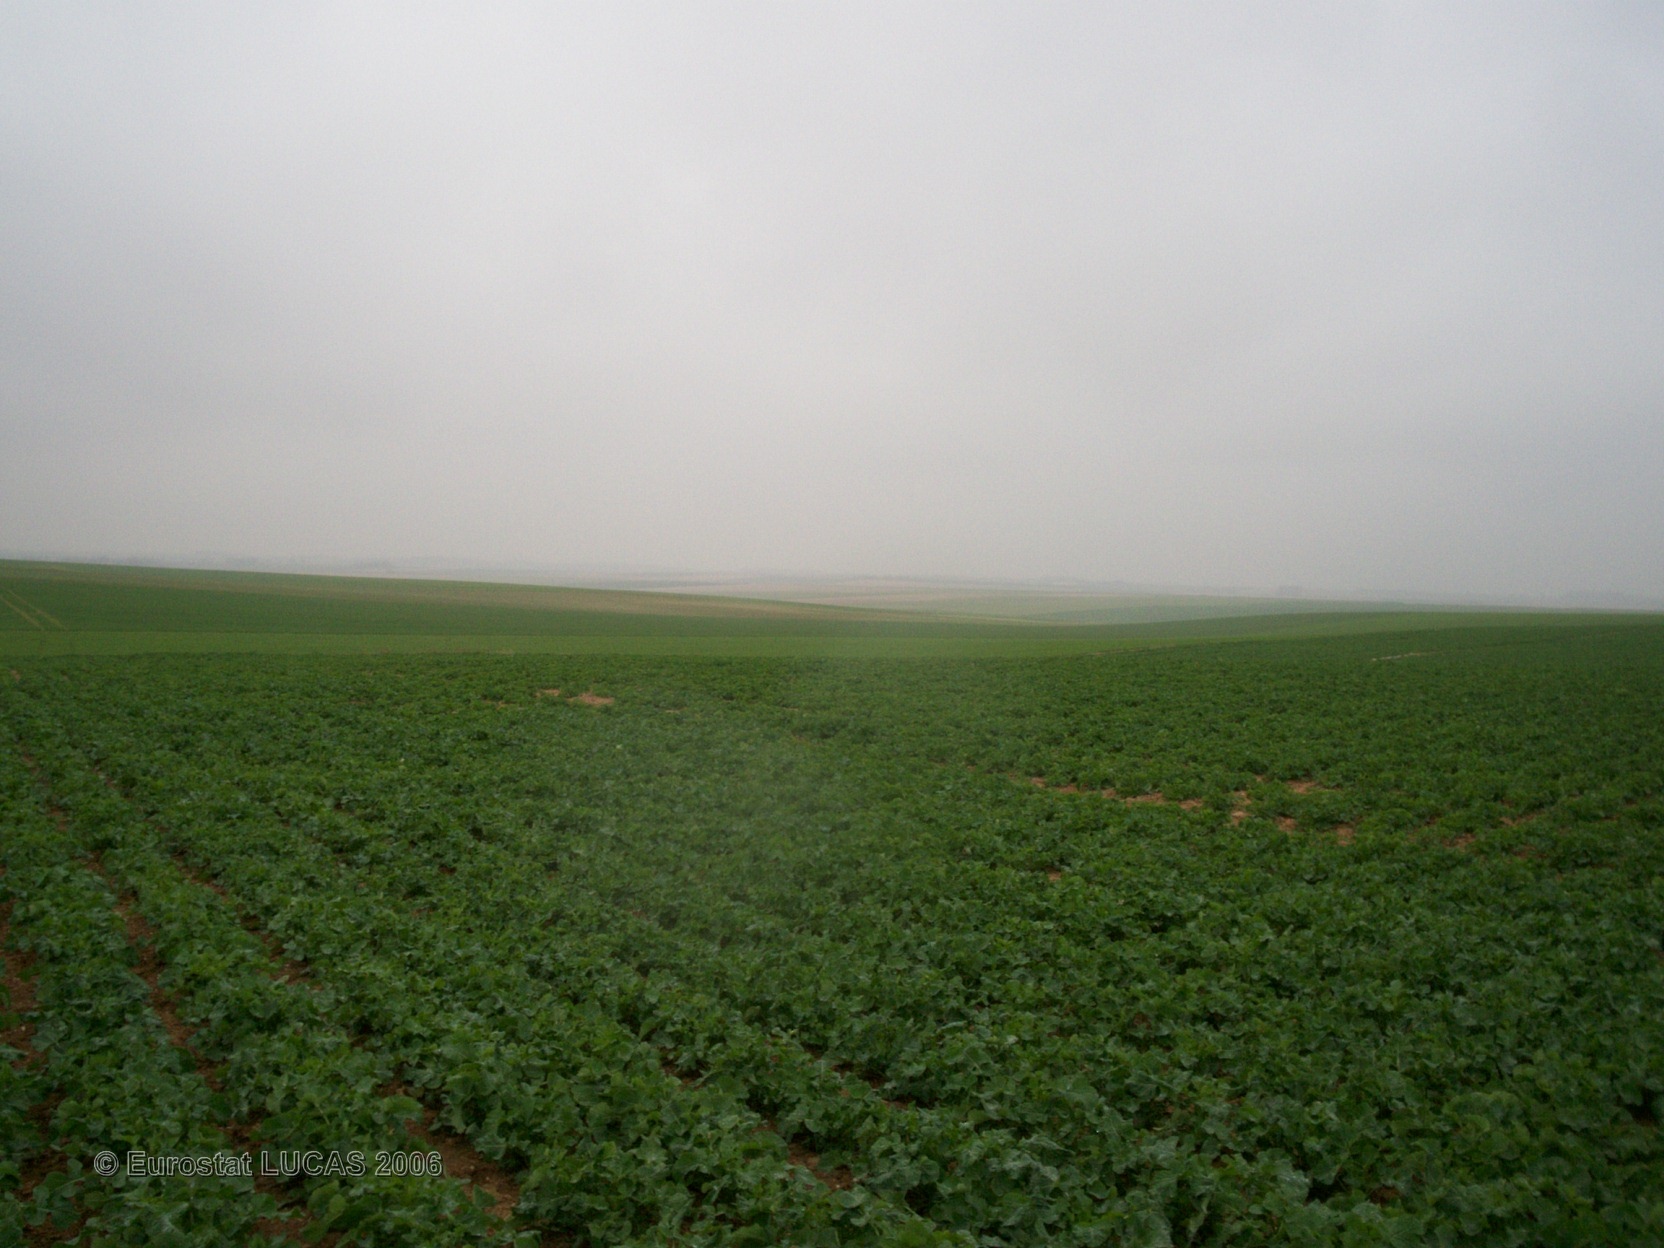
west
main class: Cropland
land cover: Rape and turnip rape
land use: Agriculture (excluding fallow land and kitchen gardens)
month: April
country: FR
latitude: 49.2451
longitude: 4.5982
